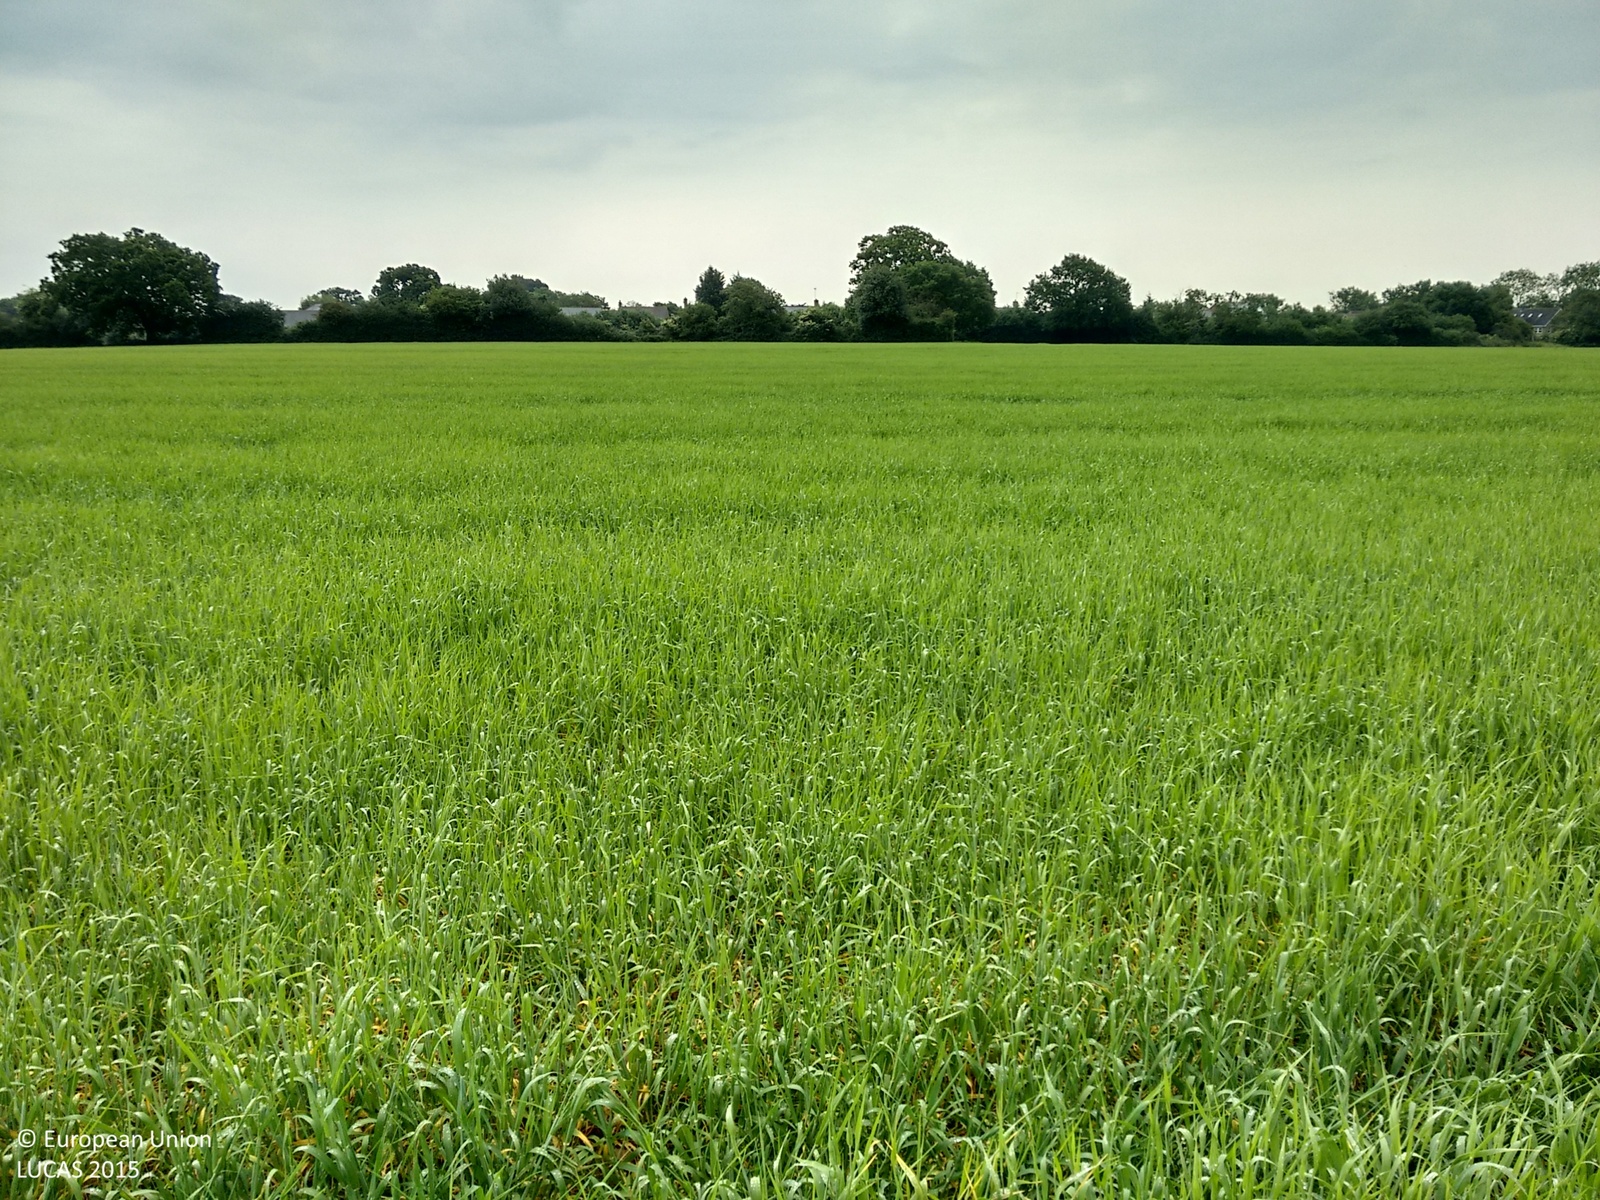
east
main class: Cropland
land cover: Barley
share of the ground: > 75 %
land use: Agriculture (excluding fallow land and kitchen gardens)
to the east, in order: Barley; Abandoned hedges; Fences; Grassland without tree/shrub cover
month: June
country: GB
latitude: 51.4777
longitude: -1.0601
